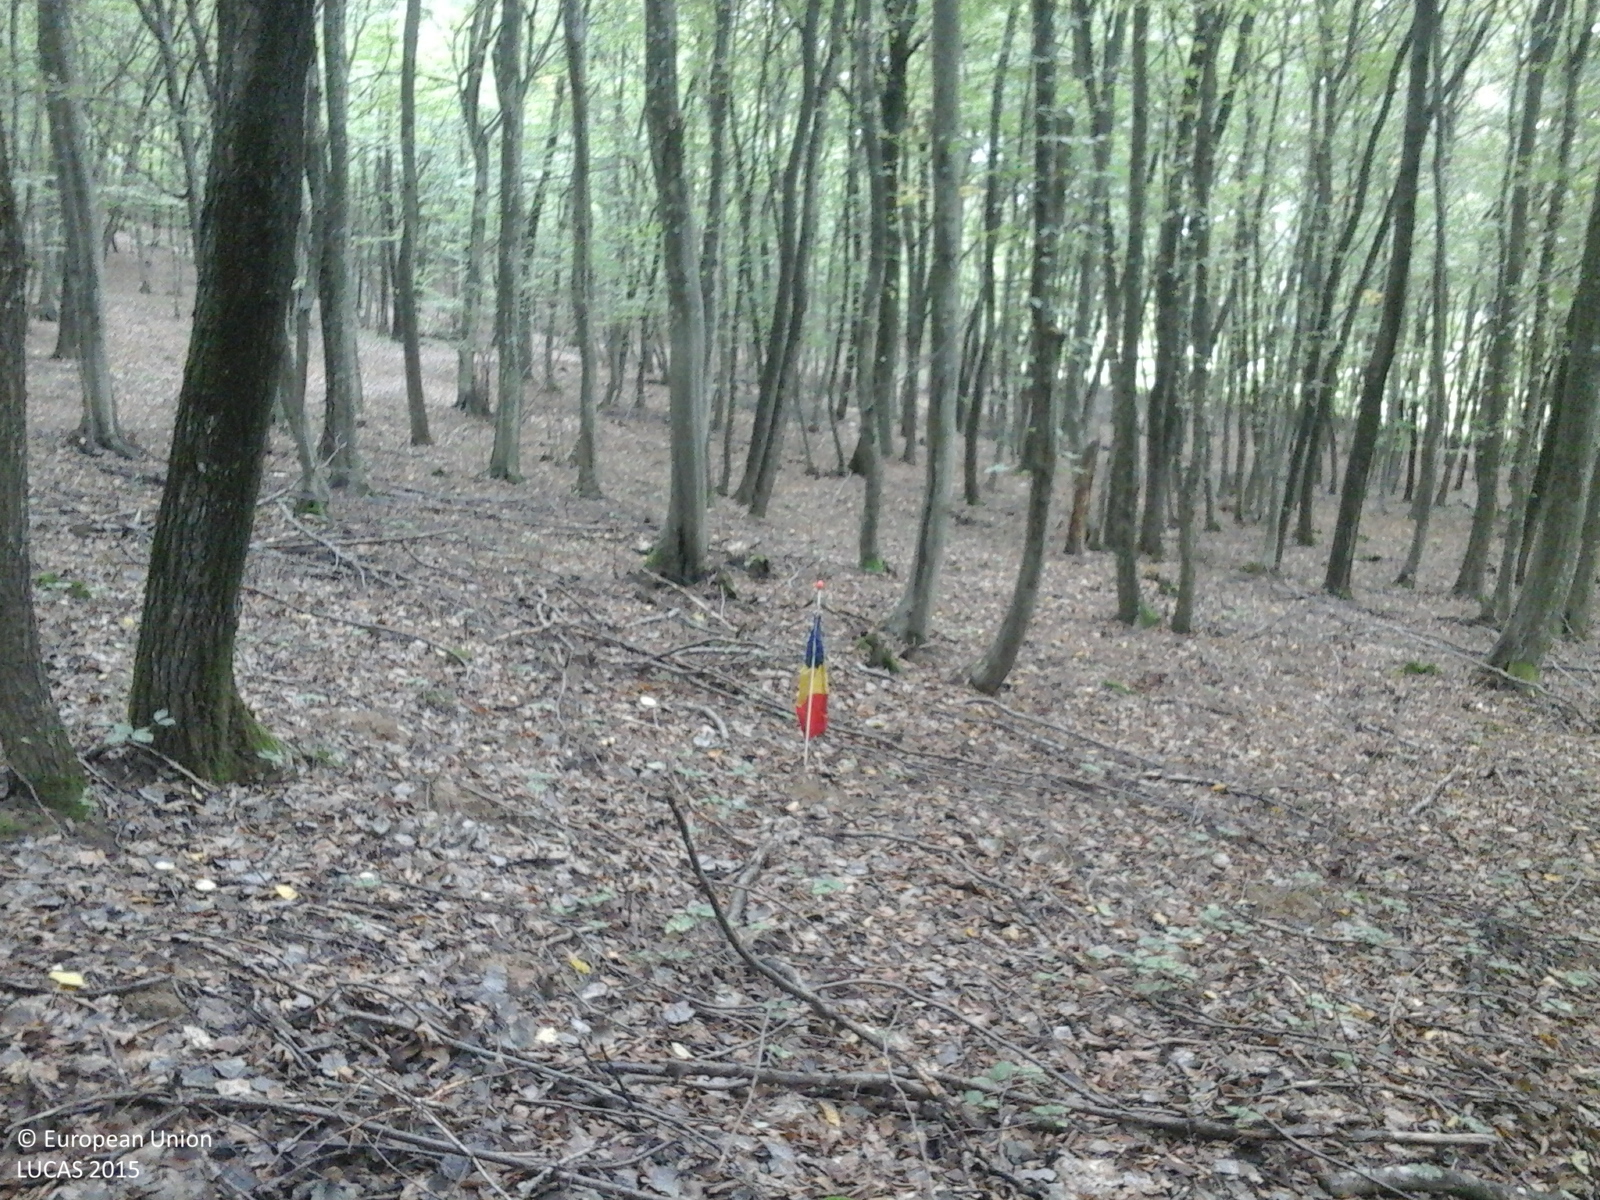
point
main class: Woodland
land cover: Broadleaved woodland
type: beech forest
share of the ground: > 75 %
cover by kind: broadleaved forest trees 100 %
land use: Forestry
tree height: > 5 m
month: October
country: RO
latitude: 46.6160
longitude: 24.7838
